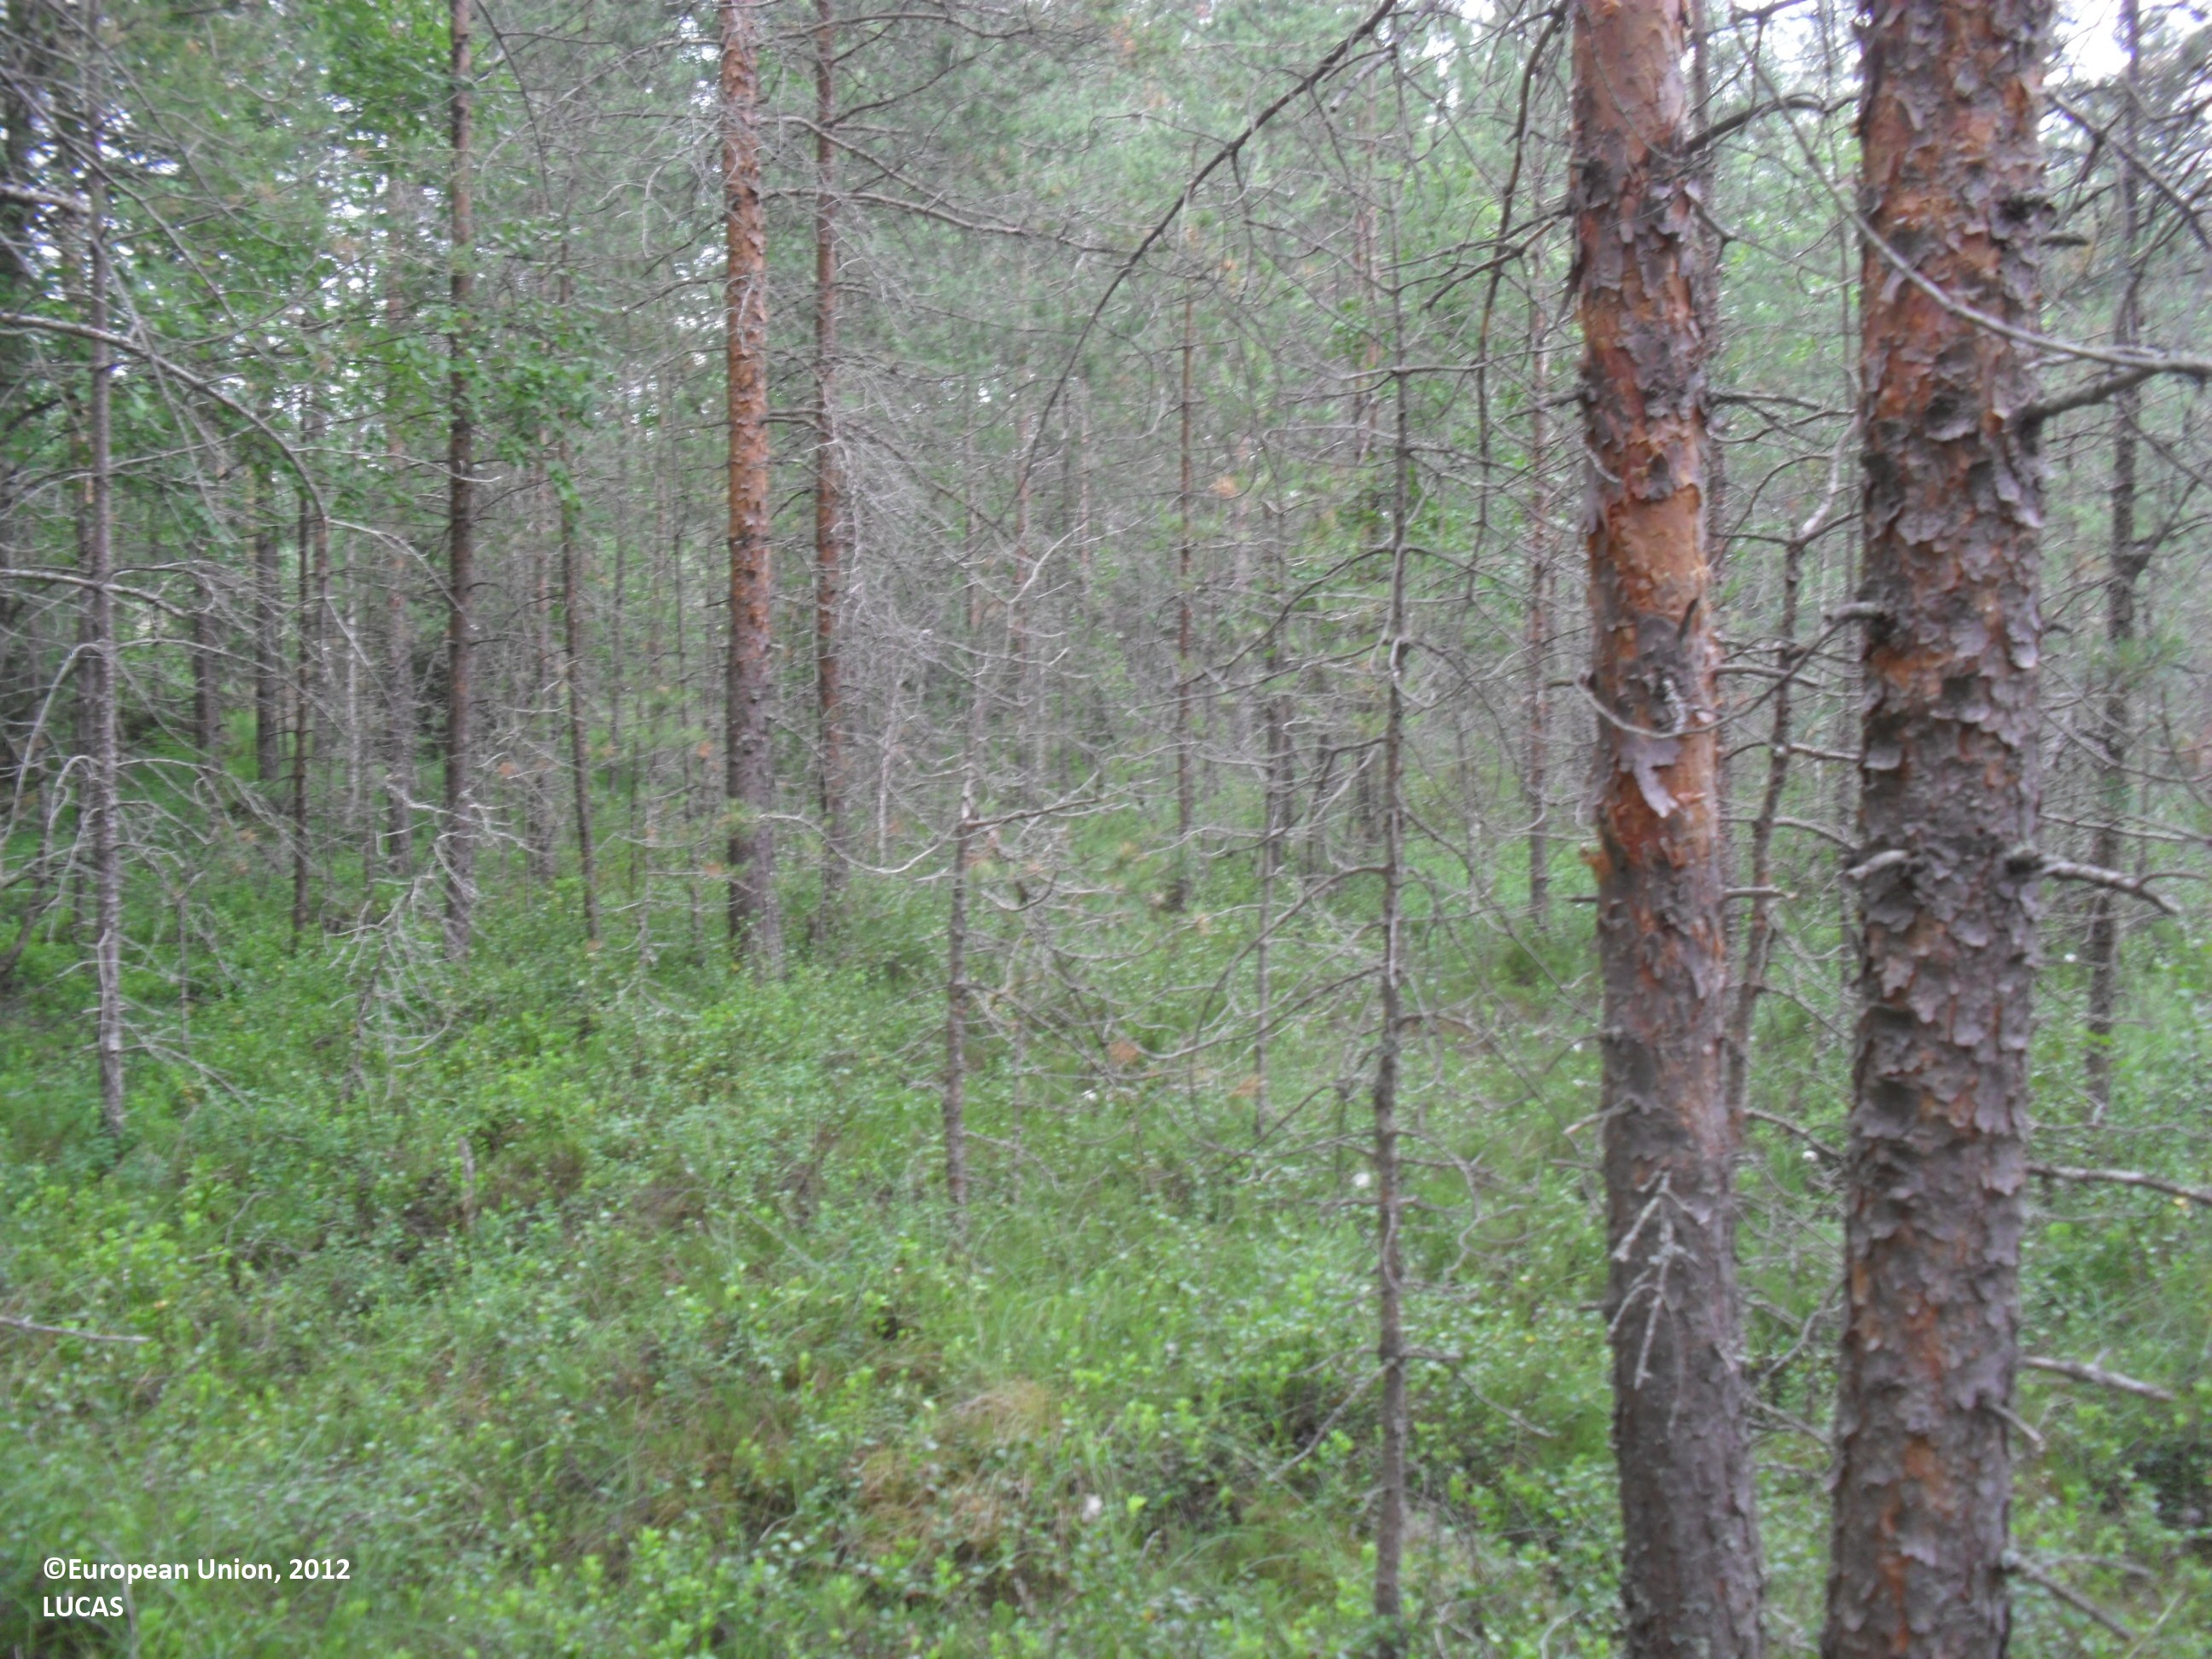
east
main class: Woodland
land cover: Pine dominated coniferous woodland
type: boreal forest
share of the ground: 50 - 75 %
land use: Forestry
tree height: > 5 m
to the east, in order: Pine dominated coniferous woodland; Pine dominated mixed woodland; Ditches and canals; Other mixed woodland; Broadleaved woodland; Grassland with sparse tree/shrub cover; Sand; Other mixed woodland; Pine dominated coniferous woodland; Paved roads, cycling and walking lanes; Other mixed woodland
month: July
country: FI
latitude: 63.6008
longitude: 23.6710
